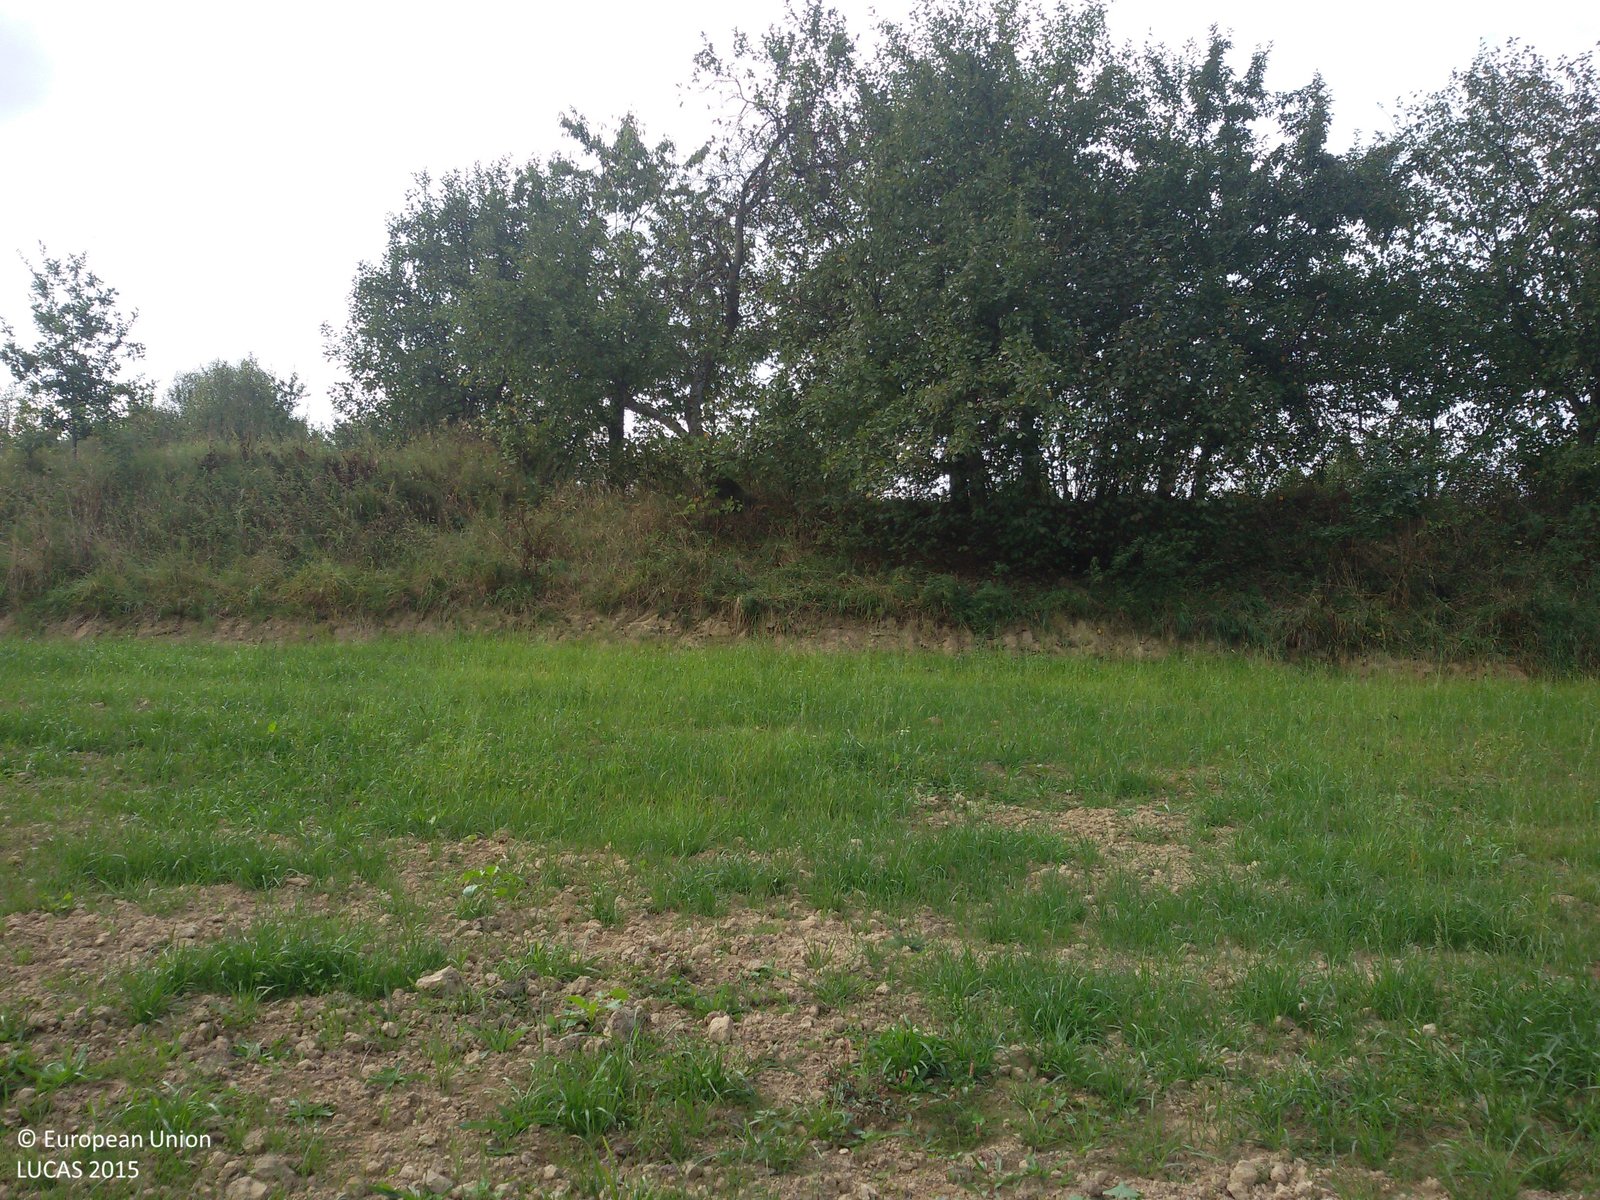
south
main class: Cropland
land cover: Rye
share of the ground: 50 - 75 %
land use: Agriculture (excluding fallow land and kitchen gardens)
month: September
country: PL
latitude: 49.7556
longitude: 21.2200
